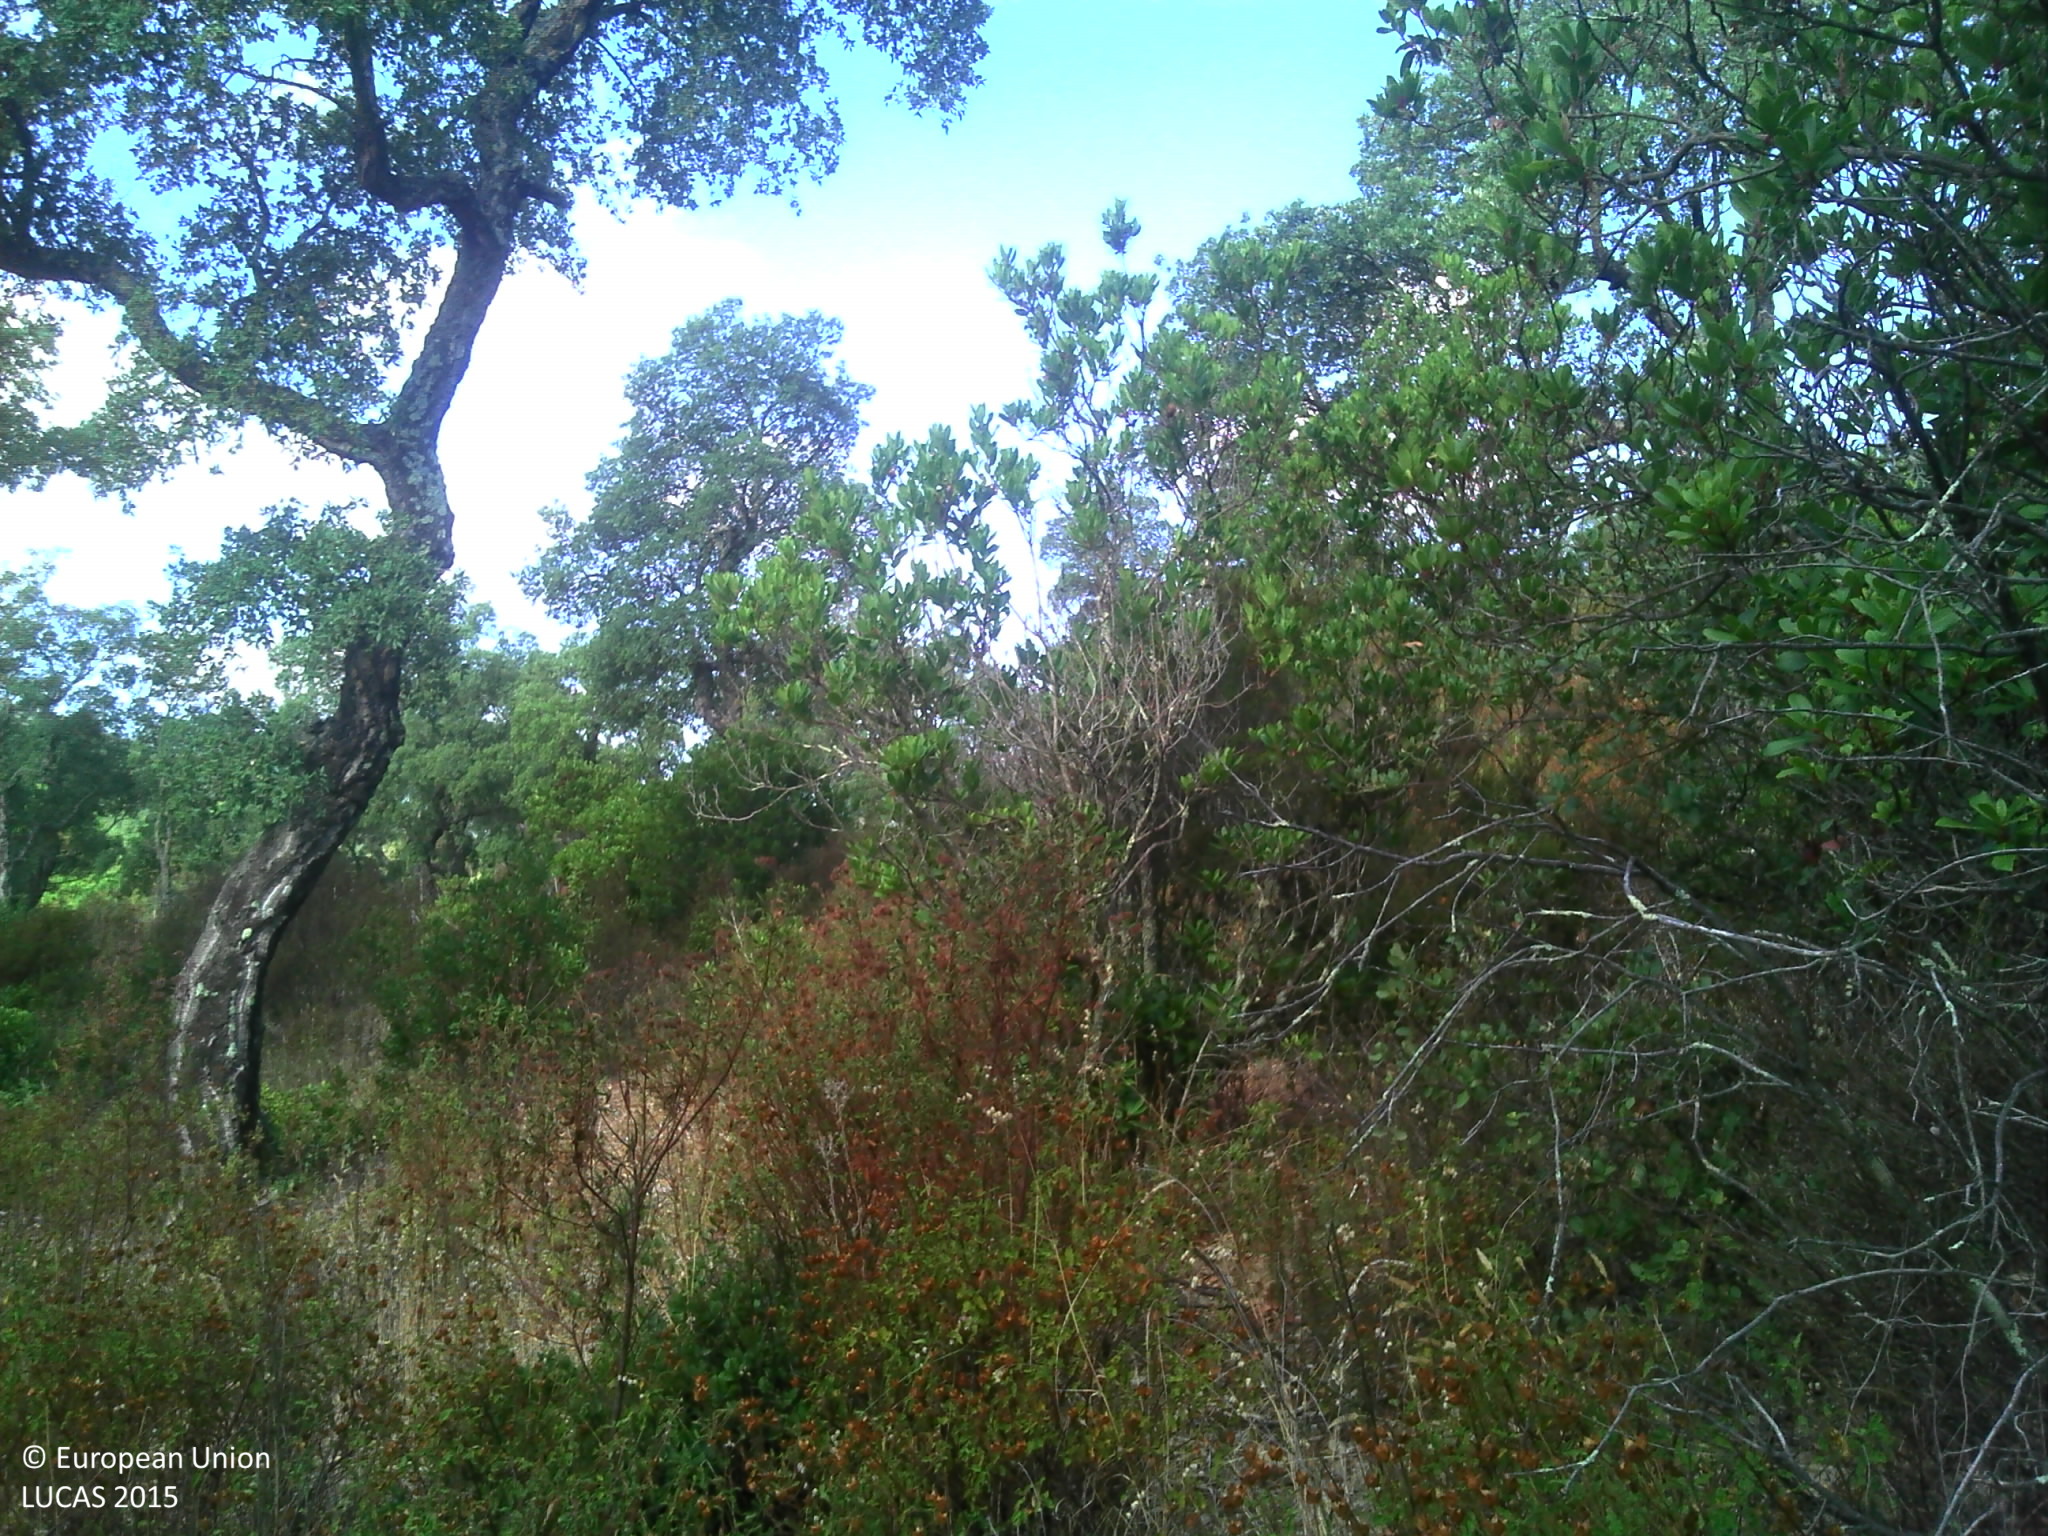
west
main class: Shrubland
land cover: Shrubland with sparse tree cover
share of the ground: > 75 %
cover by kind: shrubs 90 %, broadleaved forest trees 5 %, unconsolidated bare surface 5 %
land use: Semi-natural and natural areas not in use
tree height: < 5 m
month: July
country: FR
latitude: 43.1849
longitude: 6.3553
